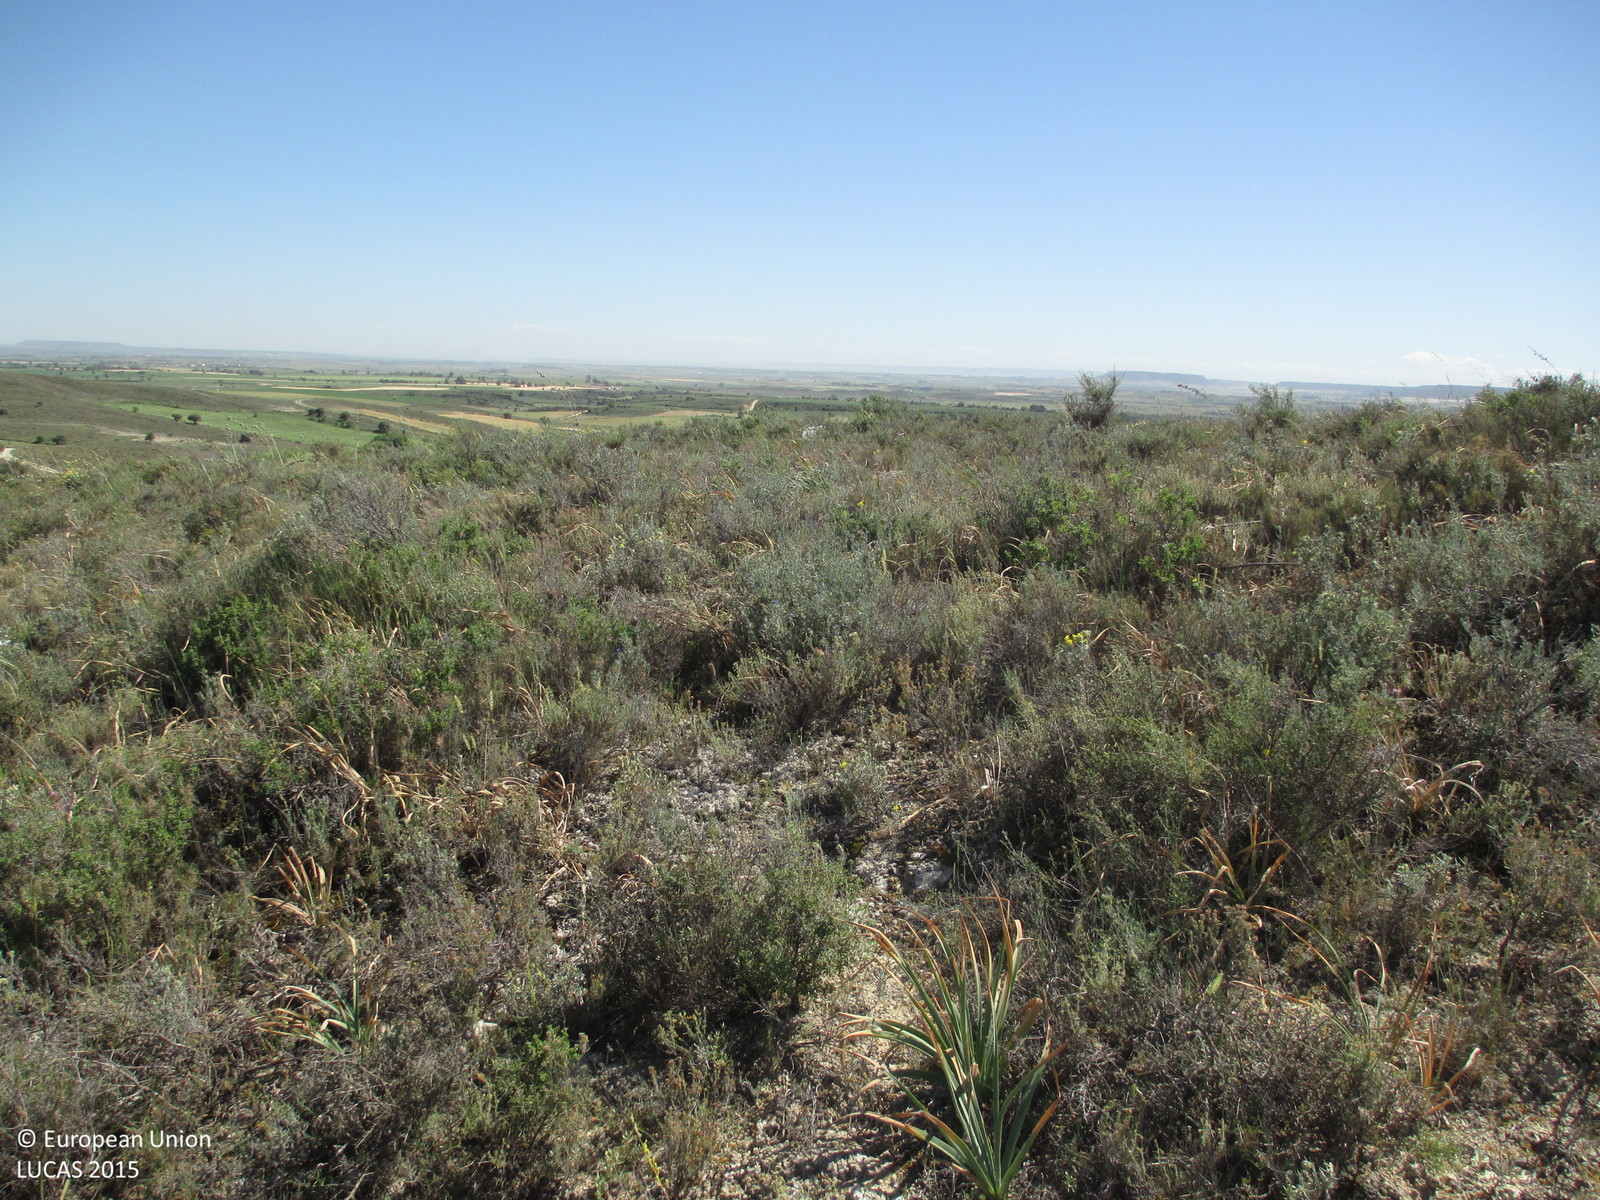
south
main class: Shrubland
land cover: Shrubland with sparse tree cover
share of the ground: > 75 %
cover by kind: shrubs 85 %, broadleaved forest trees 5 %, herbaceous plants 5 %, unconsolidated bare surface 5 %
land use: Semi-natural and natural areas not in use
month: May
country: ES
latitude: 41.9857
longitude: 0.0966
